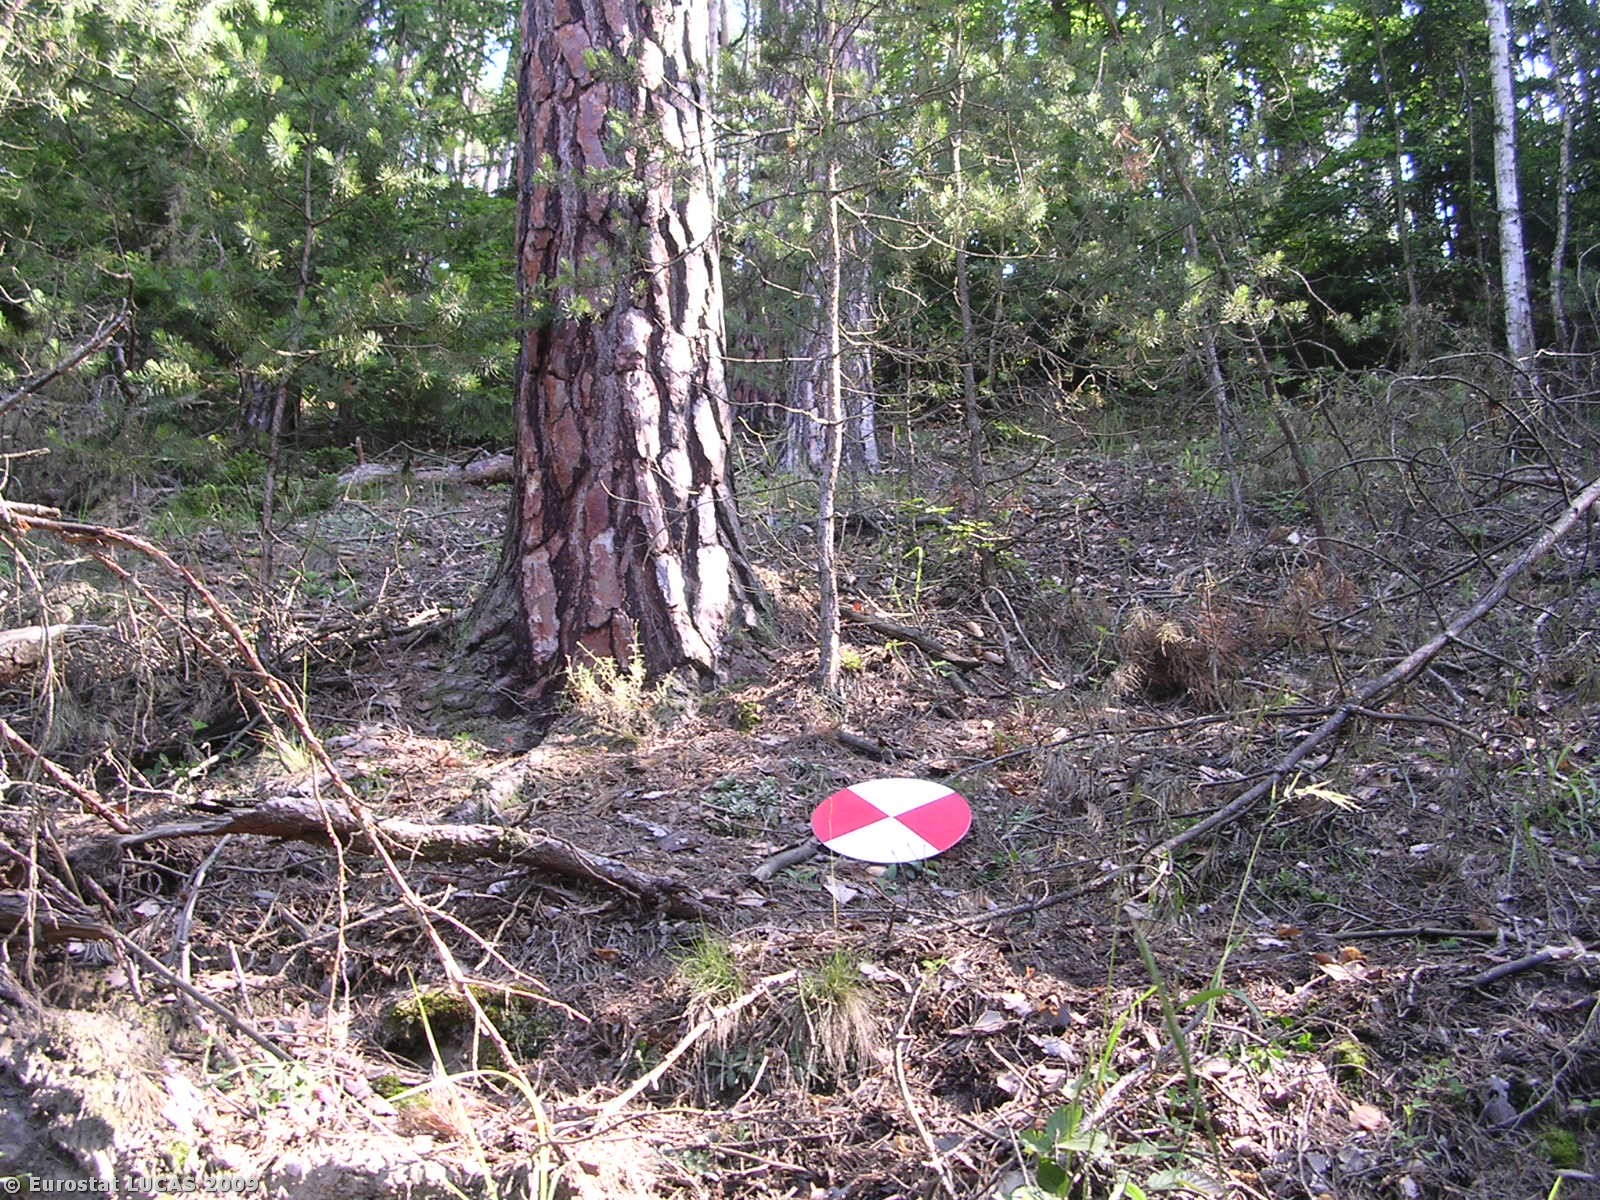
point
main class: Woodland
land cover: Coniferous woodland
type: hemiboreal forest and nemoral coniferous forest and mixed broadleaved-coniferous forest
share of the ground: > 75 %
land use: Forestry
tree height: > 5 m
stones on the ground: < 10 %
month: July
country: CZ
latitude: 50.5987
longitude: 14.9617
